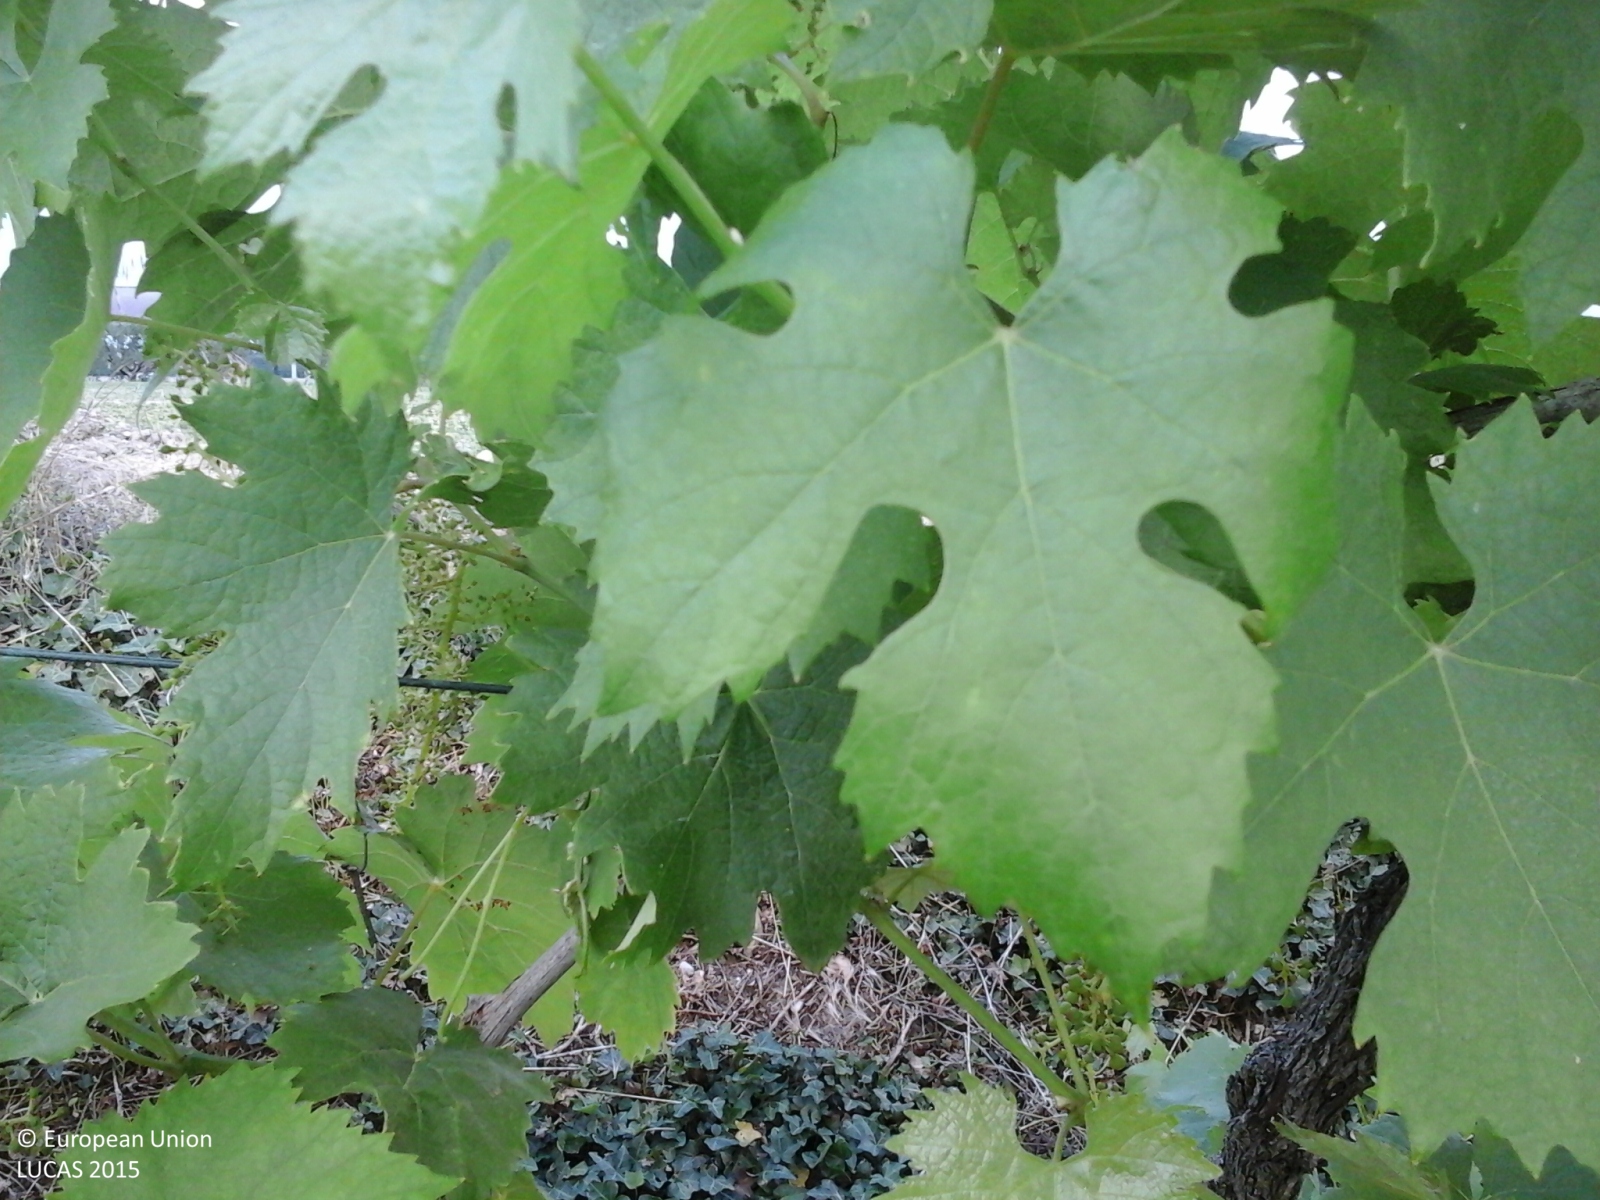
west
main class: Cropland
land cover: Vineyards
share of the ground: 25 - 50 %
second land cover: Grassland without tree/shrub cover
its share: > 75 %
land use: Agriculture (excluding fallow land and kitchen gardens)
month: June
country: IT
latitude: 45.4477
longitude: 10.7531
